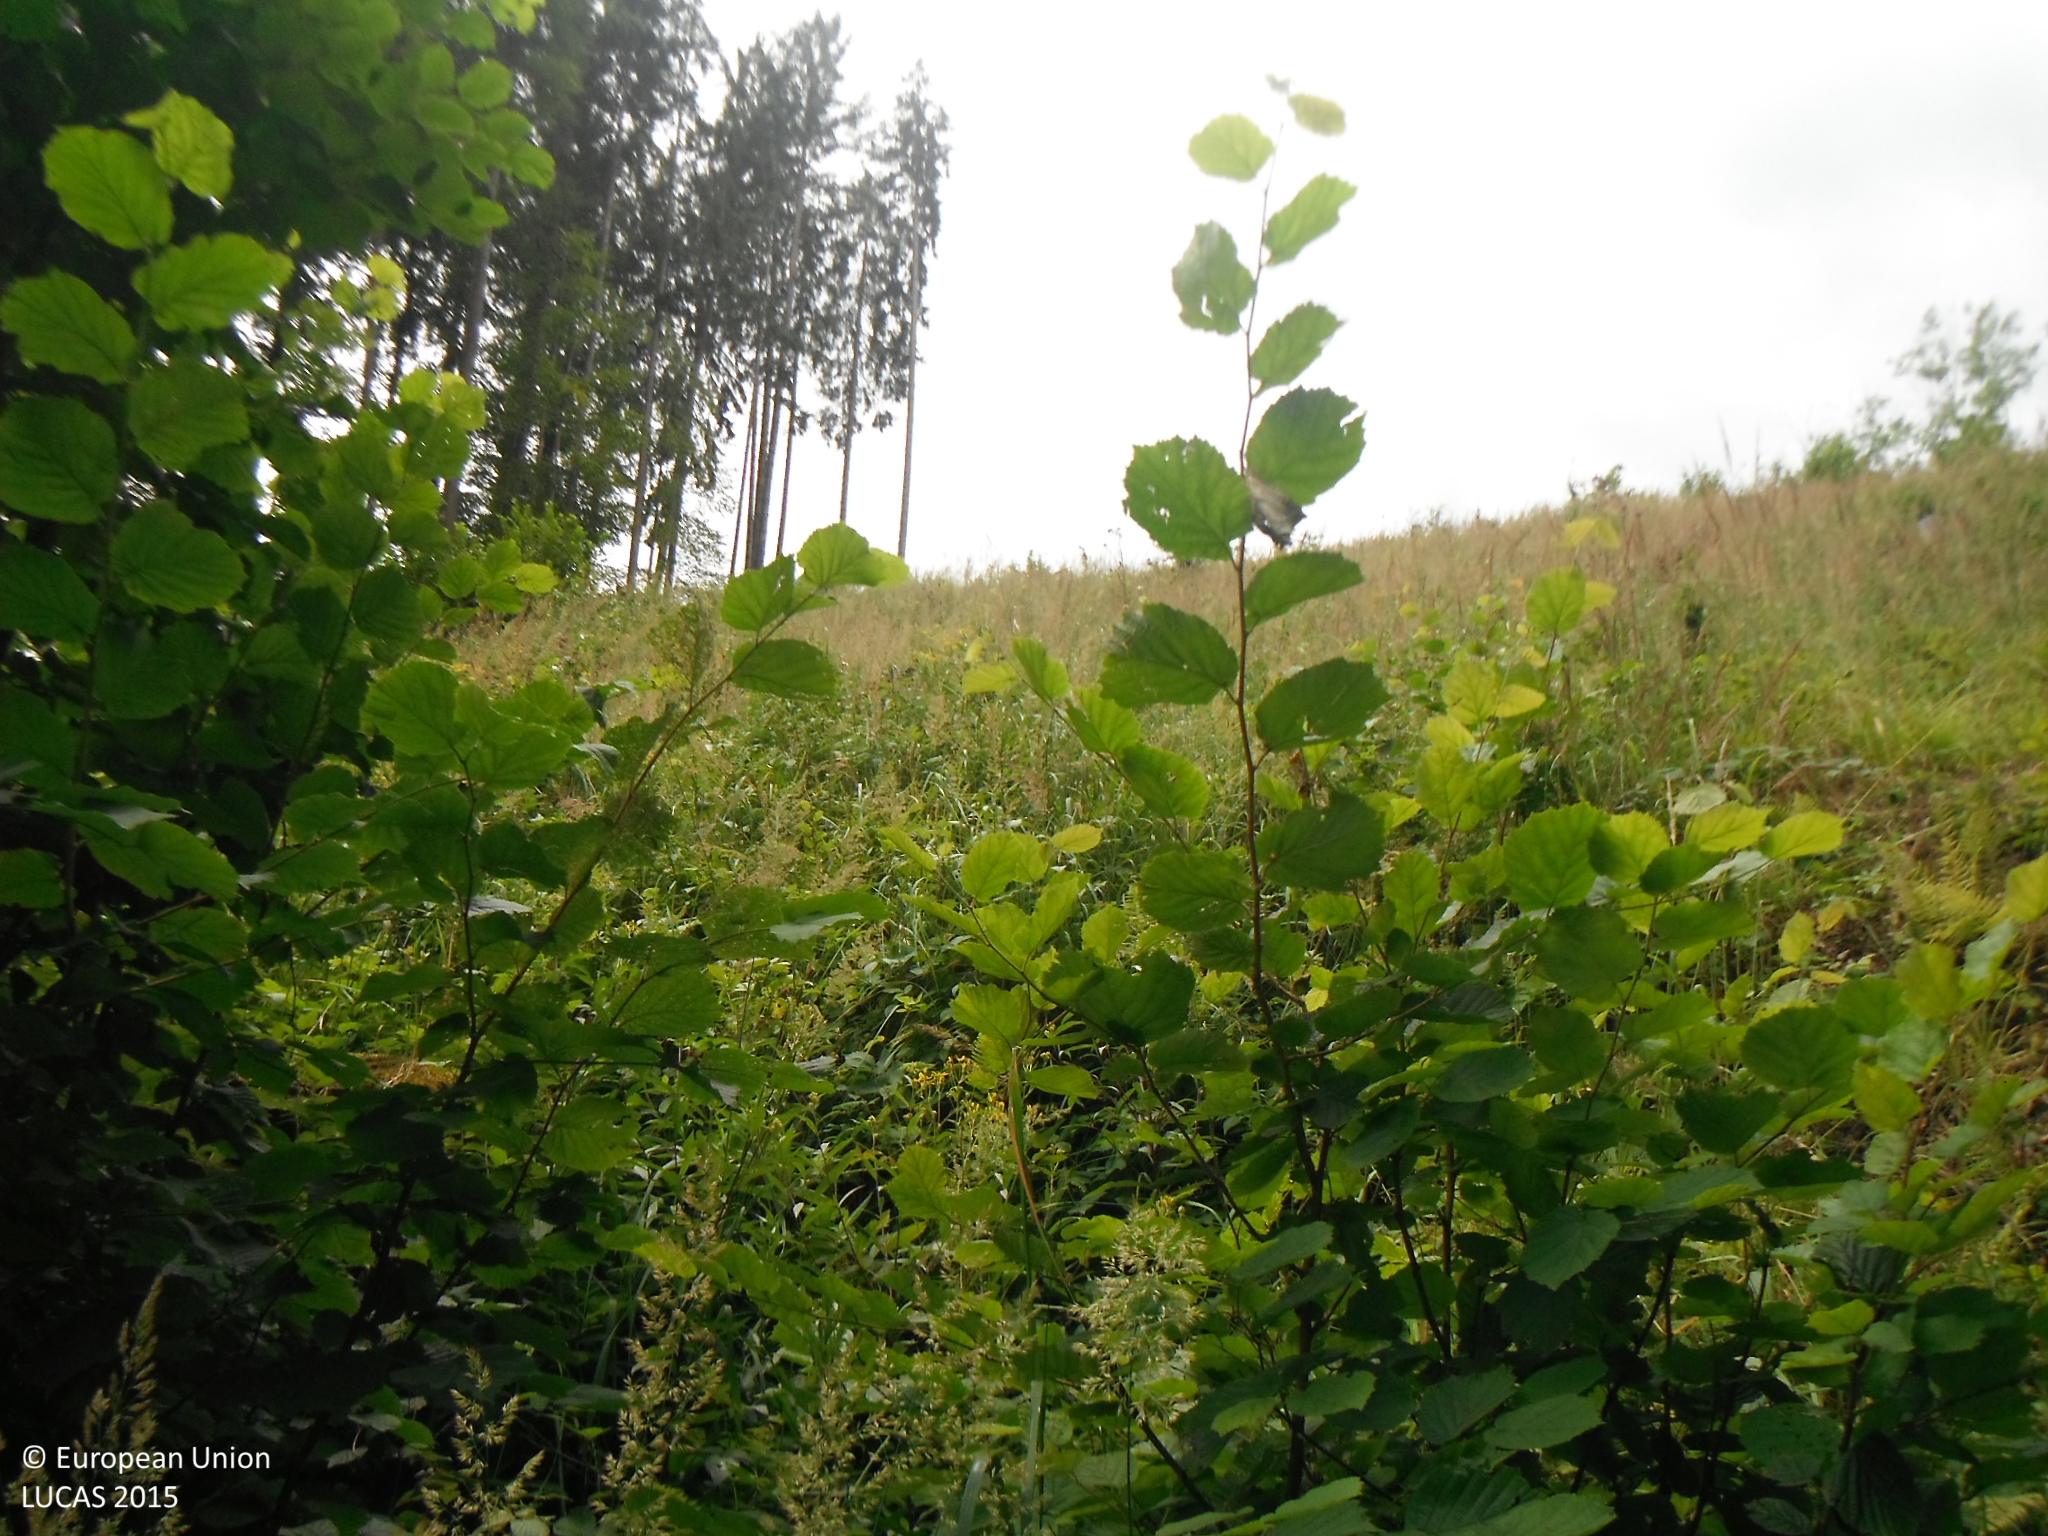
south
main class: Shrubland
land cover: Shrubland without tree cover
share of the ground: > 75 %
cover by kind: herbaceous plants 60 %, shrubs 40 %
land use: Forestry
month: July
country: SK
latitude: 49.2882
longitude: 18.2518
